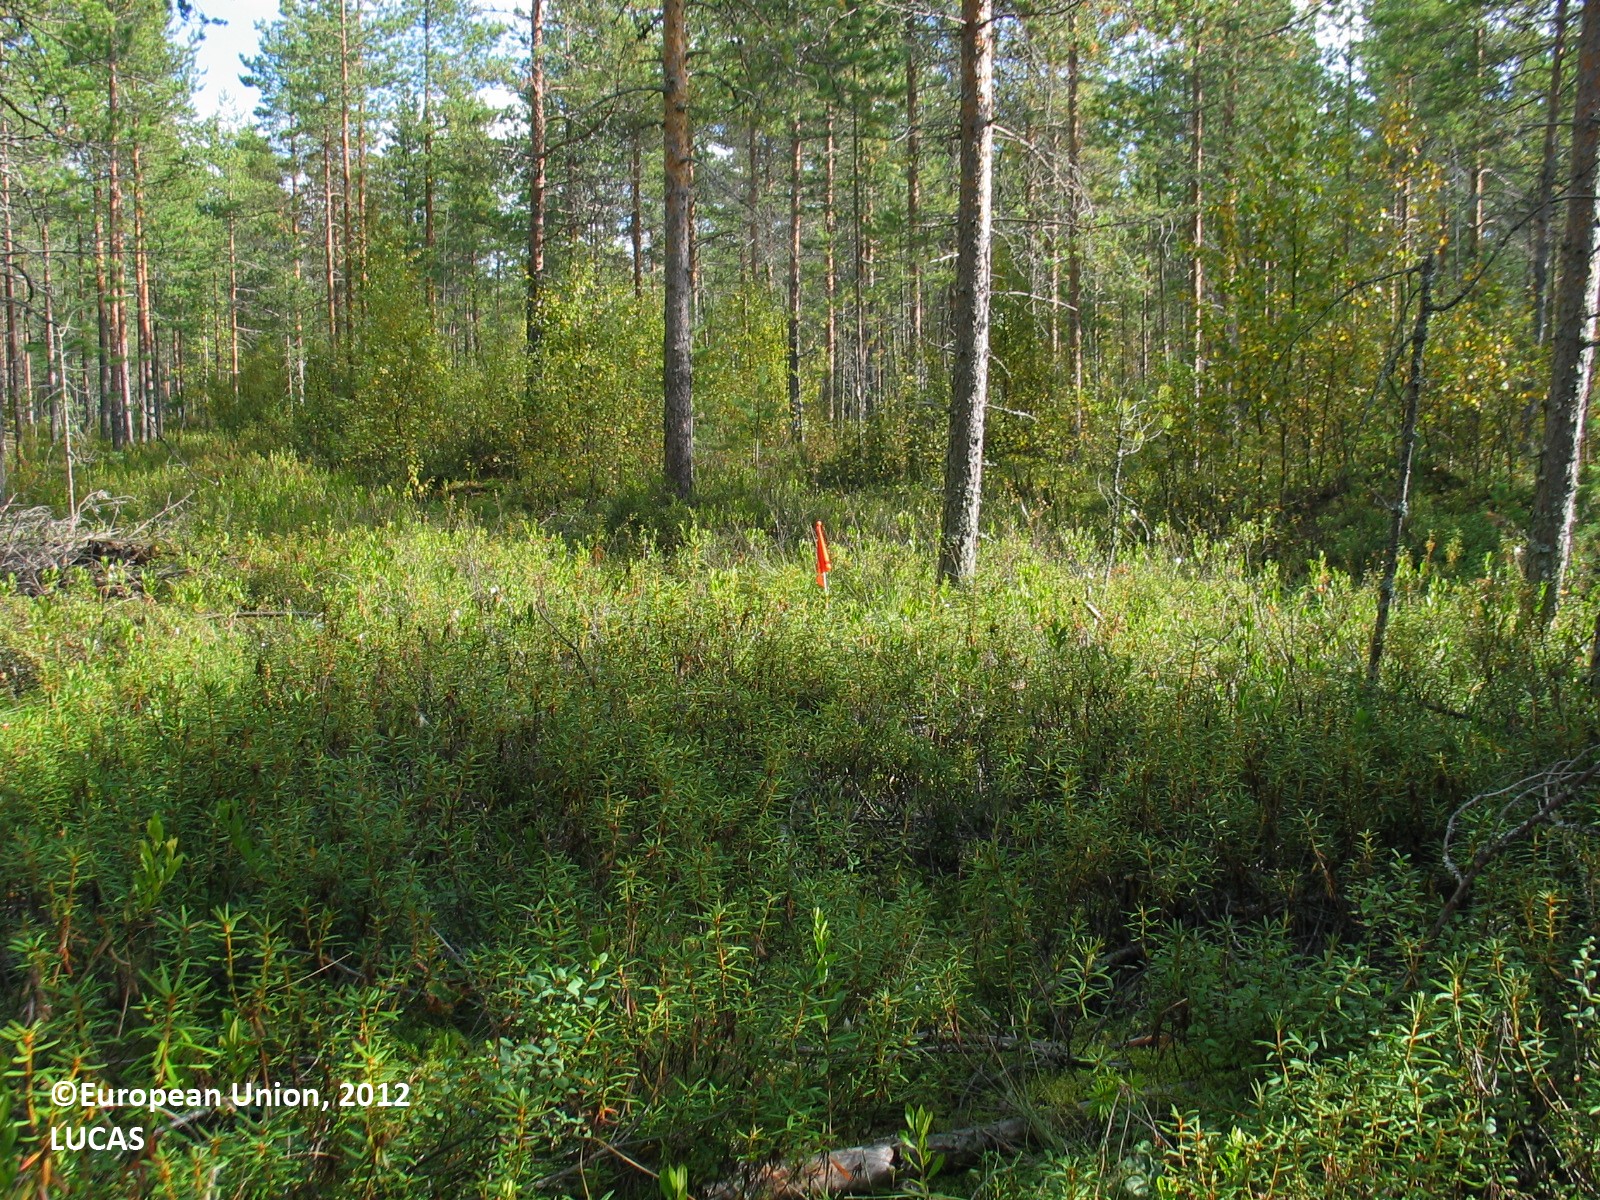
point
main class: Woodland
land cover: Pine dominated coniferous woodland
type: mire and swamp forests
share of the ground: 25 - 50 %
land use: Forestry
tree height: > 5 m
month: August
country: FI
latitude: 65.2394
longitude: 26.4300
